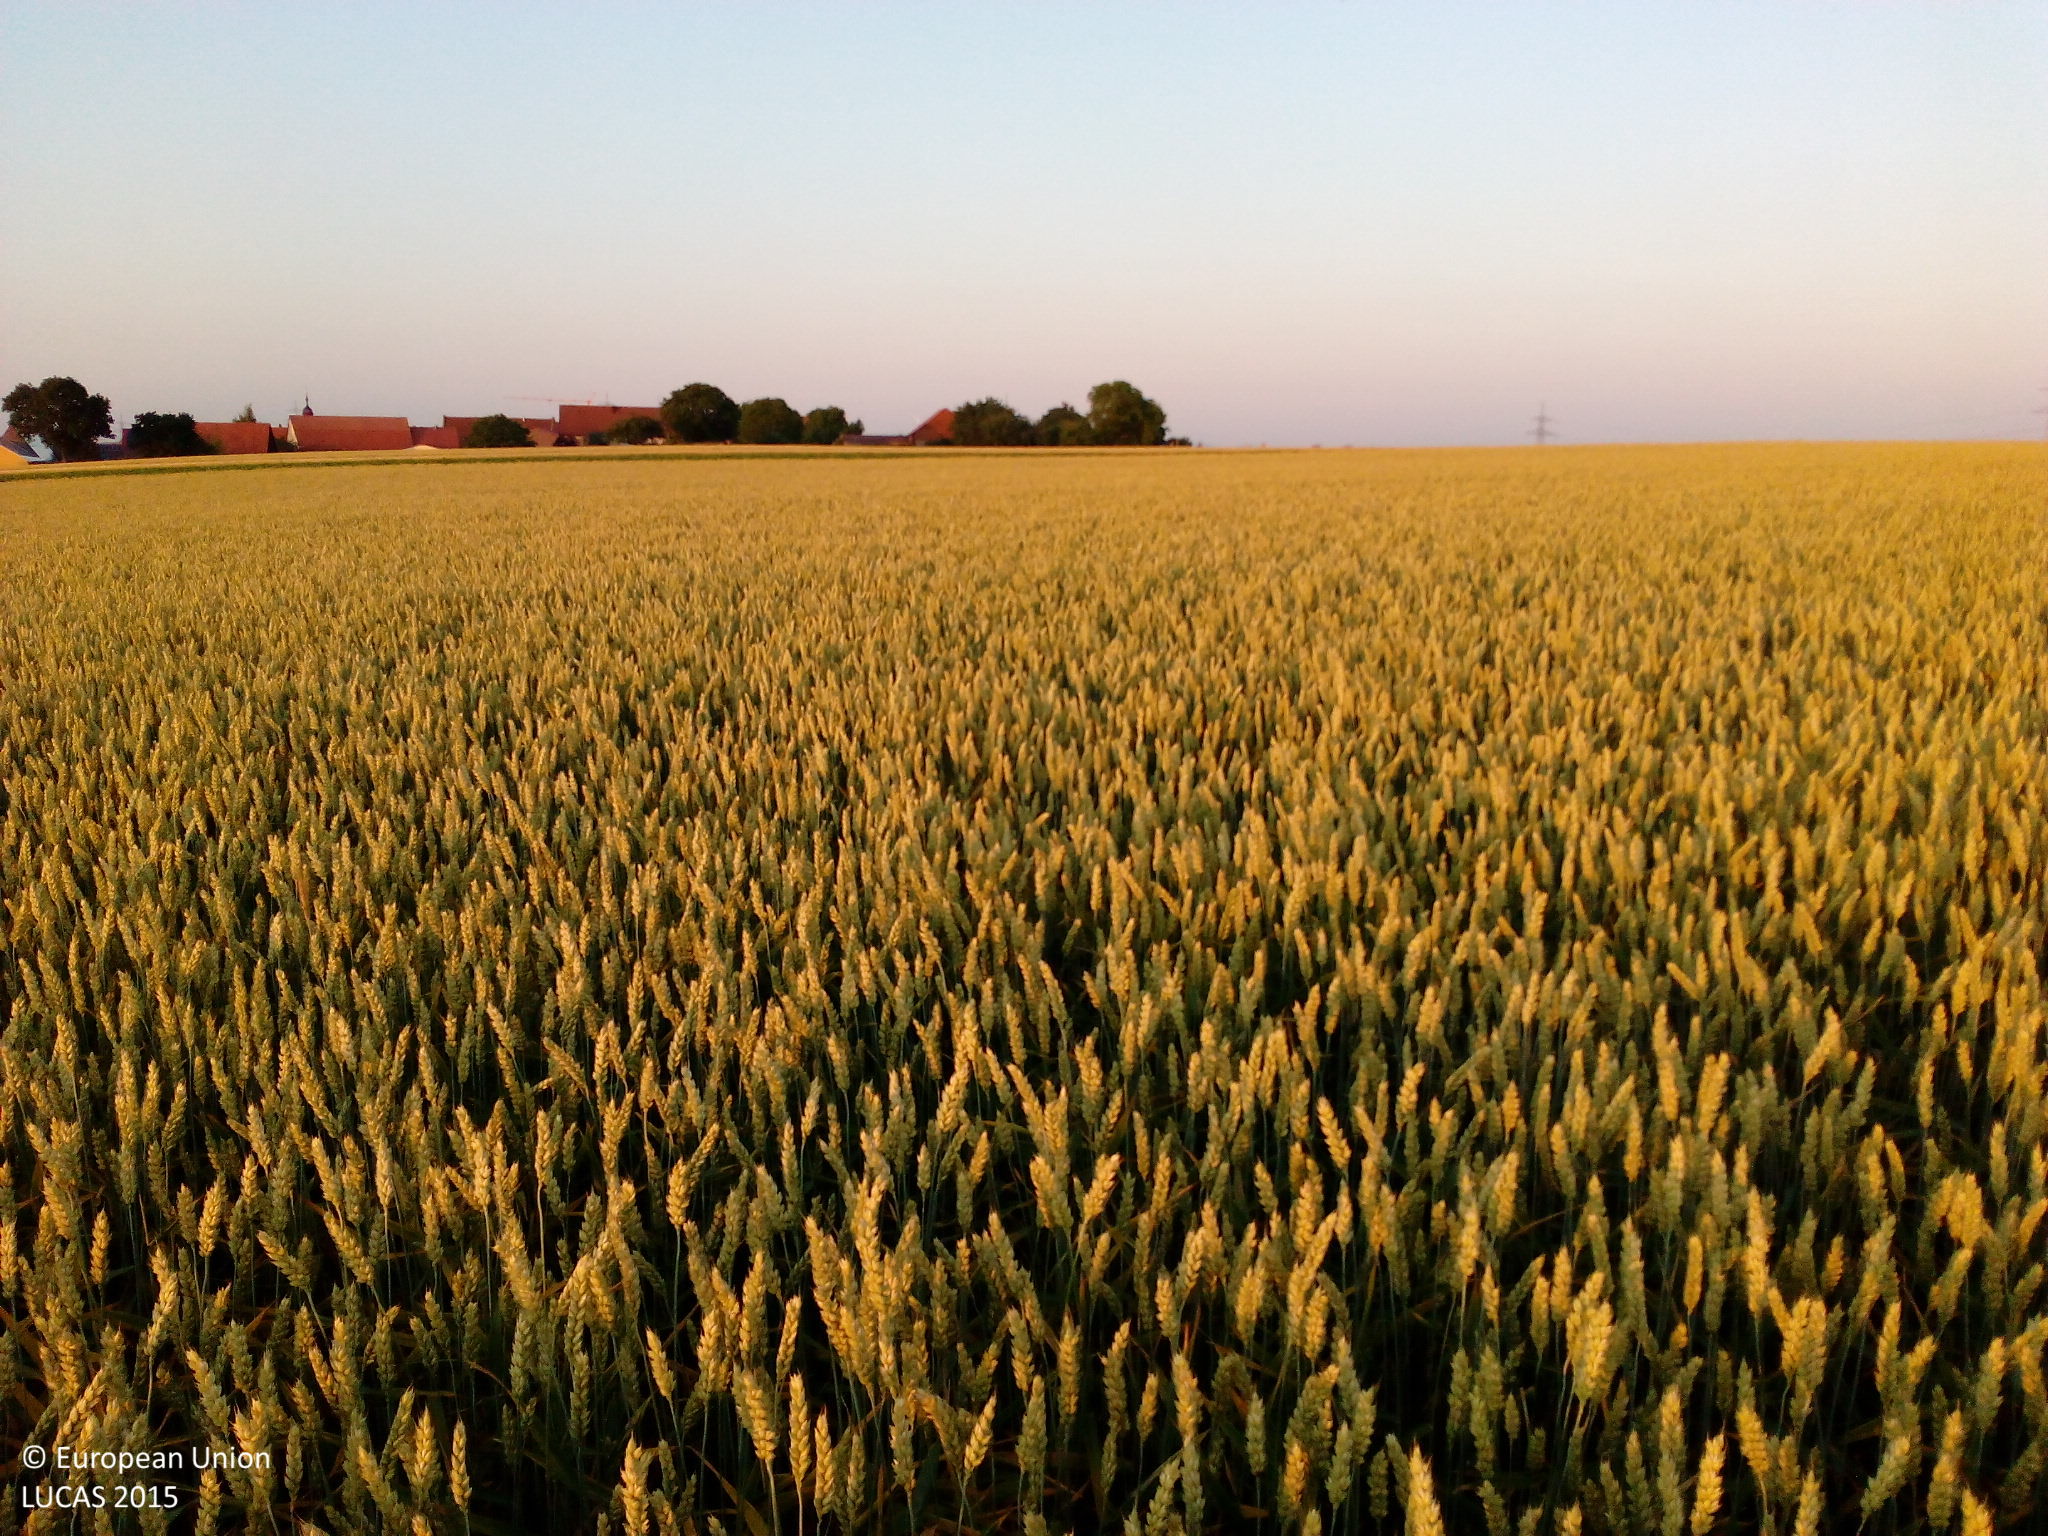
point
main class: Cropland
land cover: Common wheat
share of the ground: > 75 %
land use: Agriculture (excluding fallow land and kitchen gardens)
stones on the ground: < 10 %
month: July
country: DE
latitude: 49.5908
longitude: 9.9585
